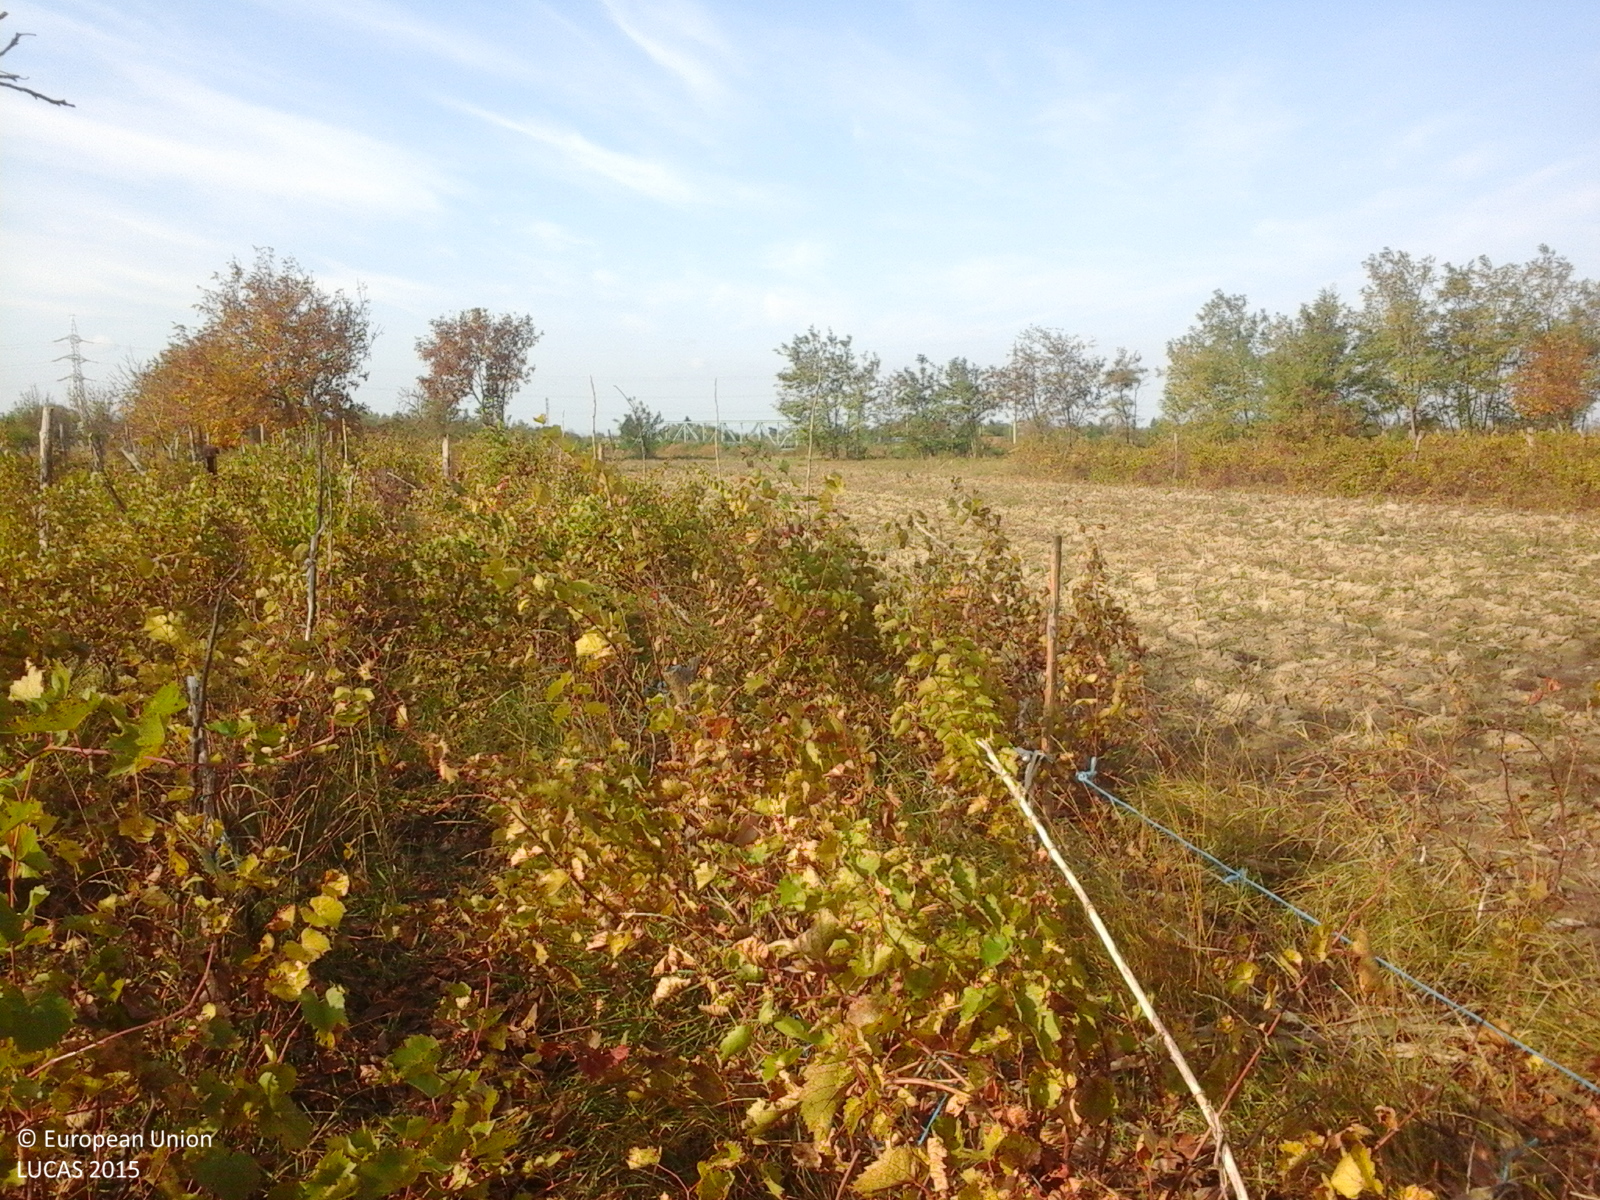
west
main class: Cropland
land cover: Vineyards
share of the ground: > 75 %
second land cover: Spontaneously vegetated surfaces
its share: 50 - 75 %
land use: Agriculture (excluding fallow land and kitchen gardens)
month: October
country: RO
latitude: 45.5101
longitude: 27.3392
